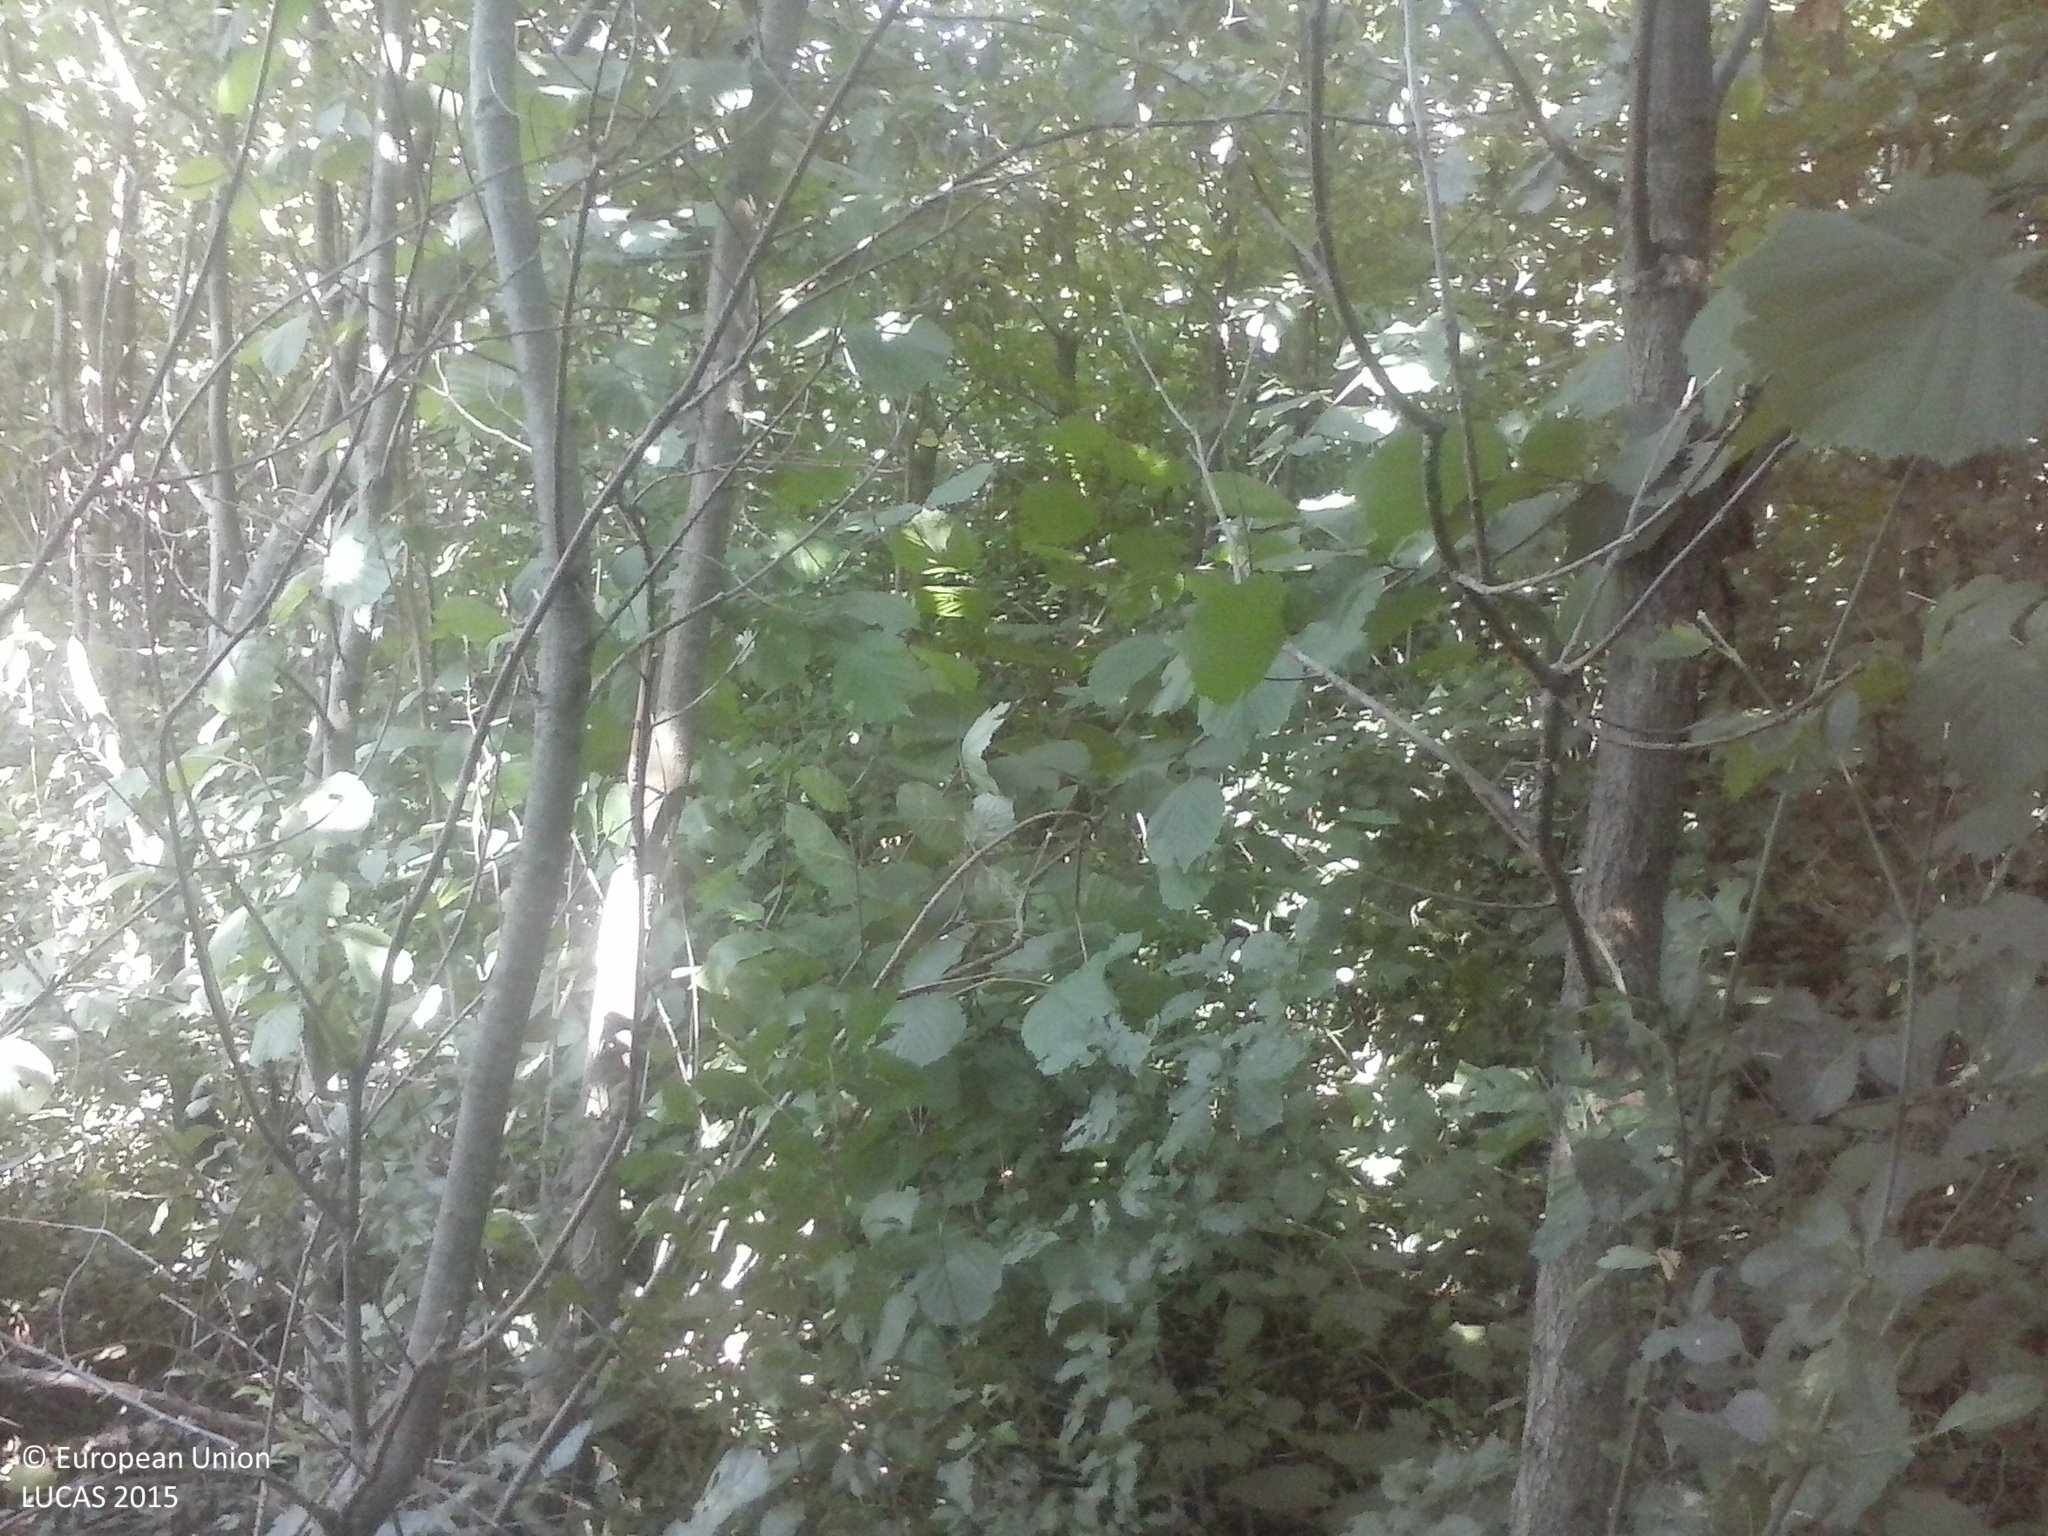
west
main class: Woodland
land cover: Broadleaved woodland
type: mesophytic deciduous forest
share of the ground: > 75 %
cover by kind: broadleaved forest trees 90 %, shrubs 10 %
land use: Forestry
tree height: > 5 m
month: August
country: HU
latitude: 45.9274
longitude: 17.9617
